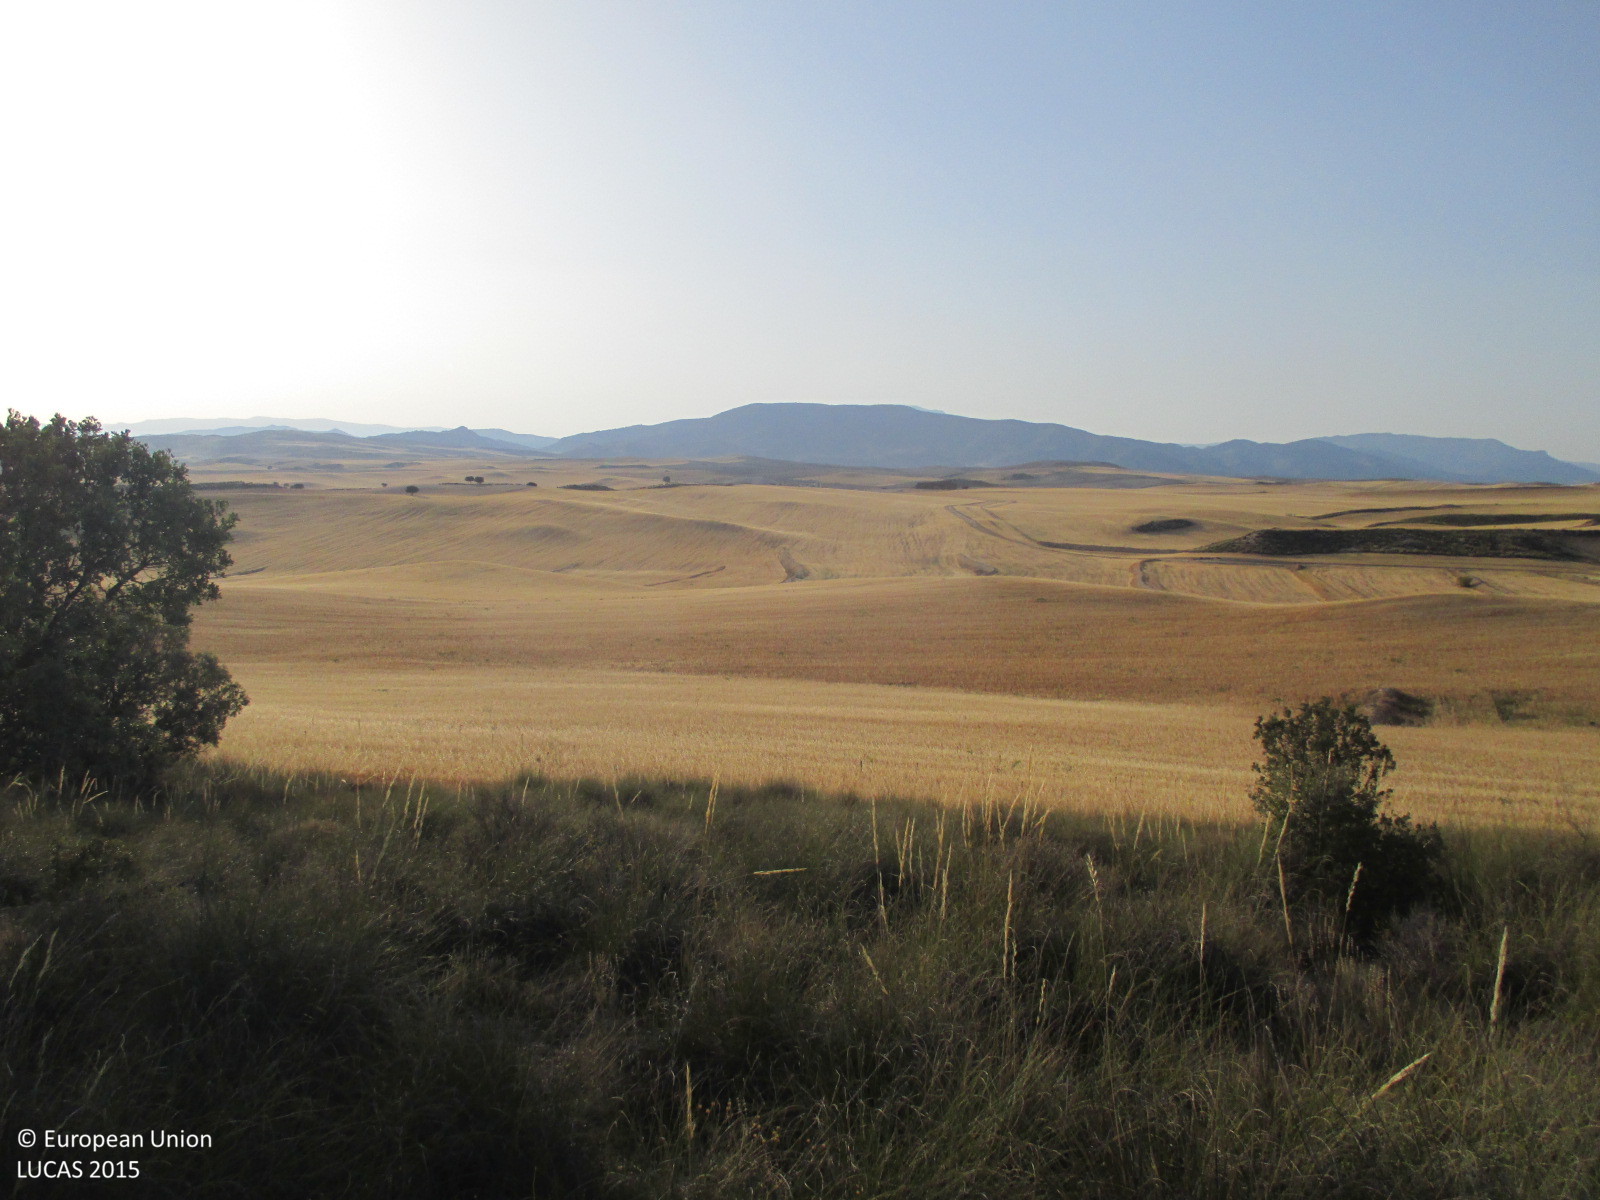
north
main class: Cropland
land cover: Oats
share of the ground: 25 - 50 %
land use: Agriculture (excluding fallow land and kitchen gardens)
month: June
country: ES
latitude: 37.7728
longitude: -2.4200
